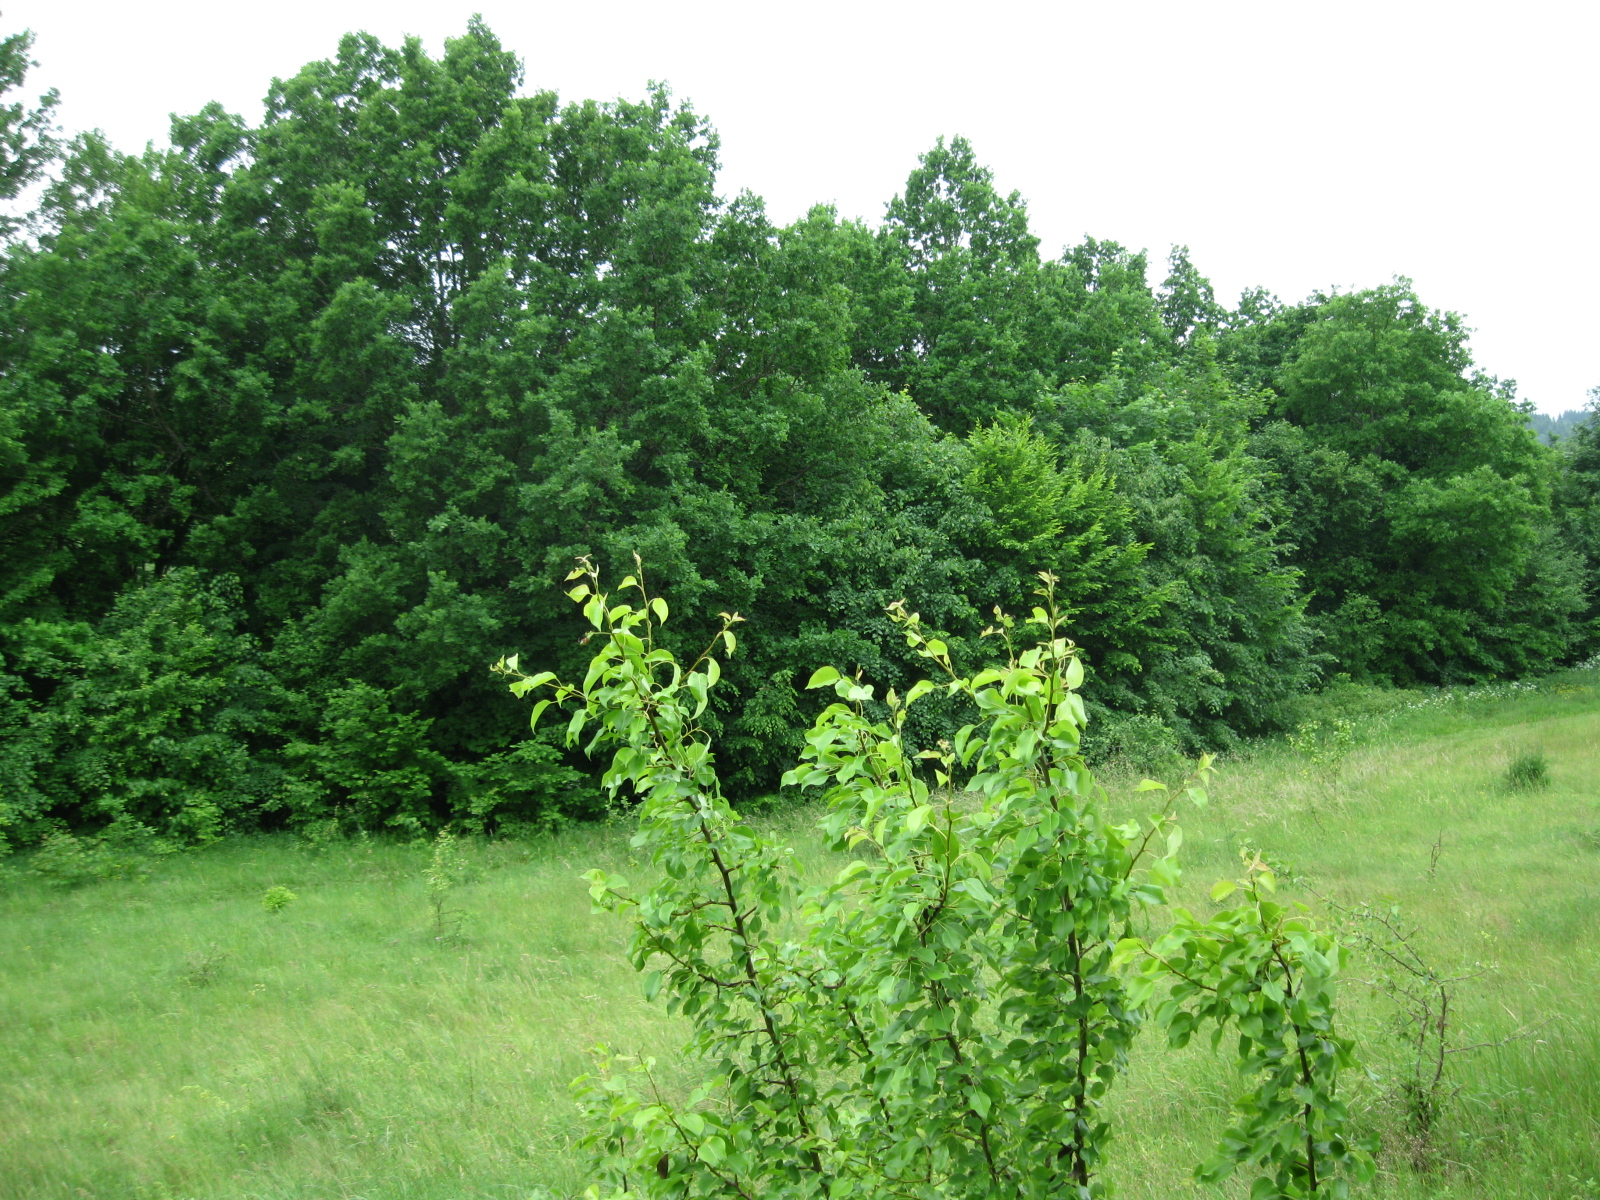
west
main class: Woodland
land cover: Broadleaved woodland
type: non-riverine alder, birch or aspen forest
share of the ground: > 75 %
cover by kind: broadleaved forest trees 85 %, herbaceous plants 10 %, lichens and mosses 5 %
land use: Semi-natural and natural areas not in use
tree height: > 5 m
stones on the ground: < 10 %
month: June
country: LT
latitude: 55.2510
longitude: 23.4988
